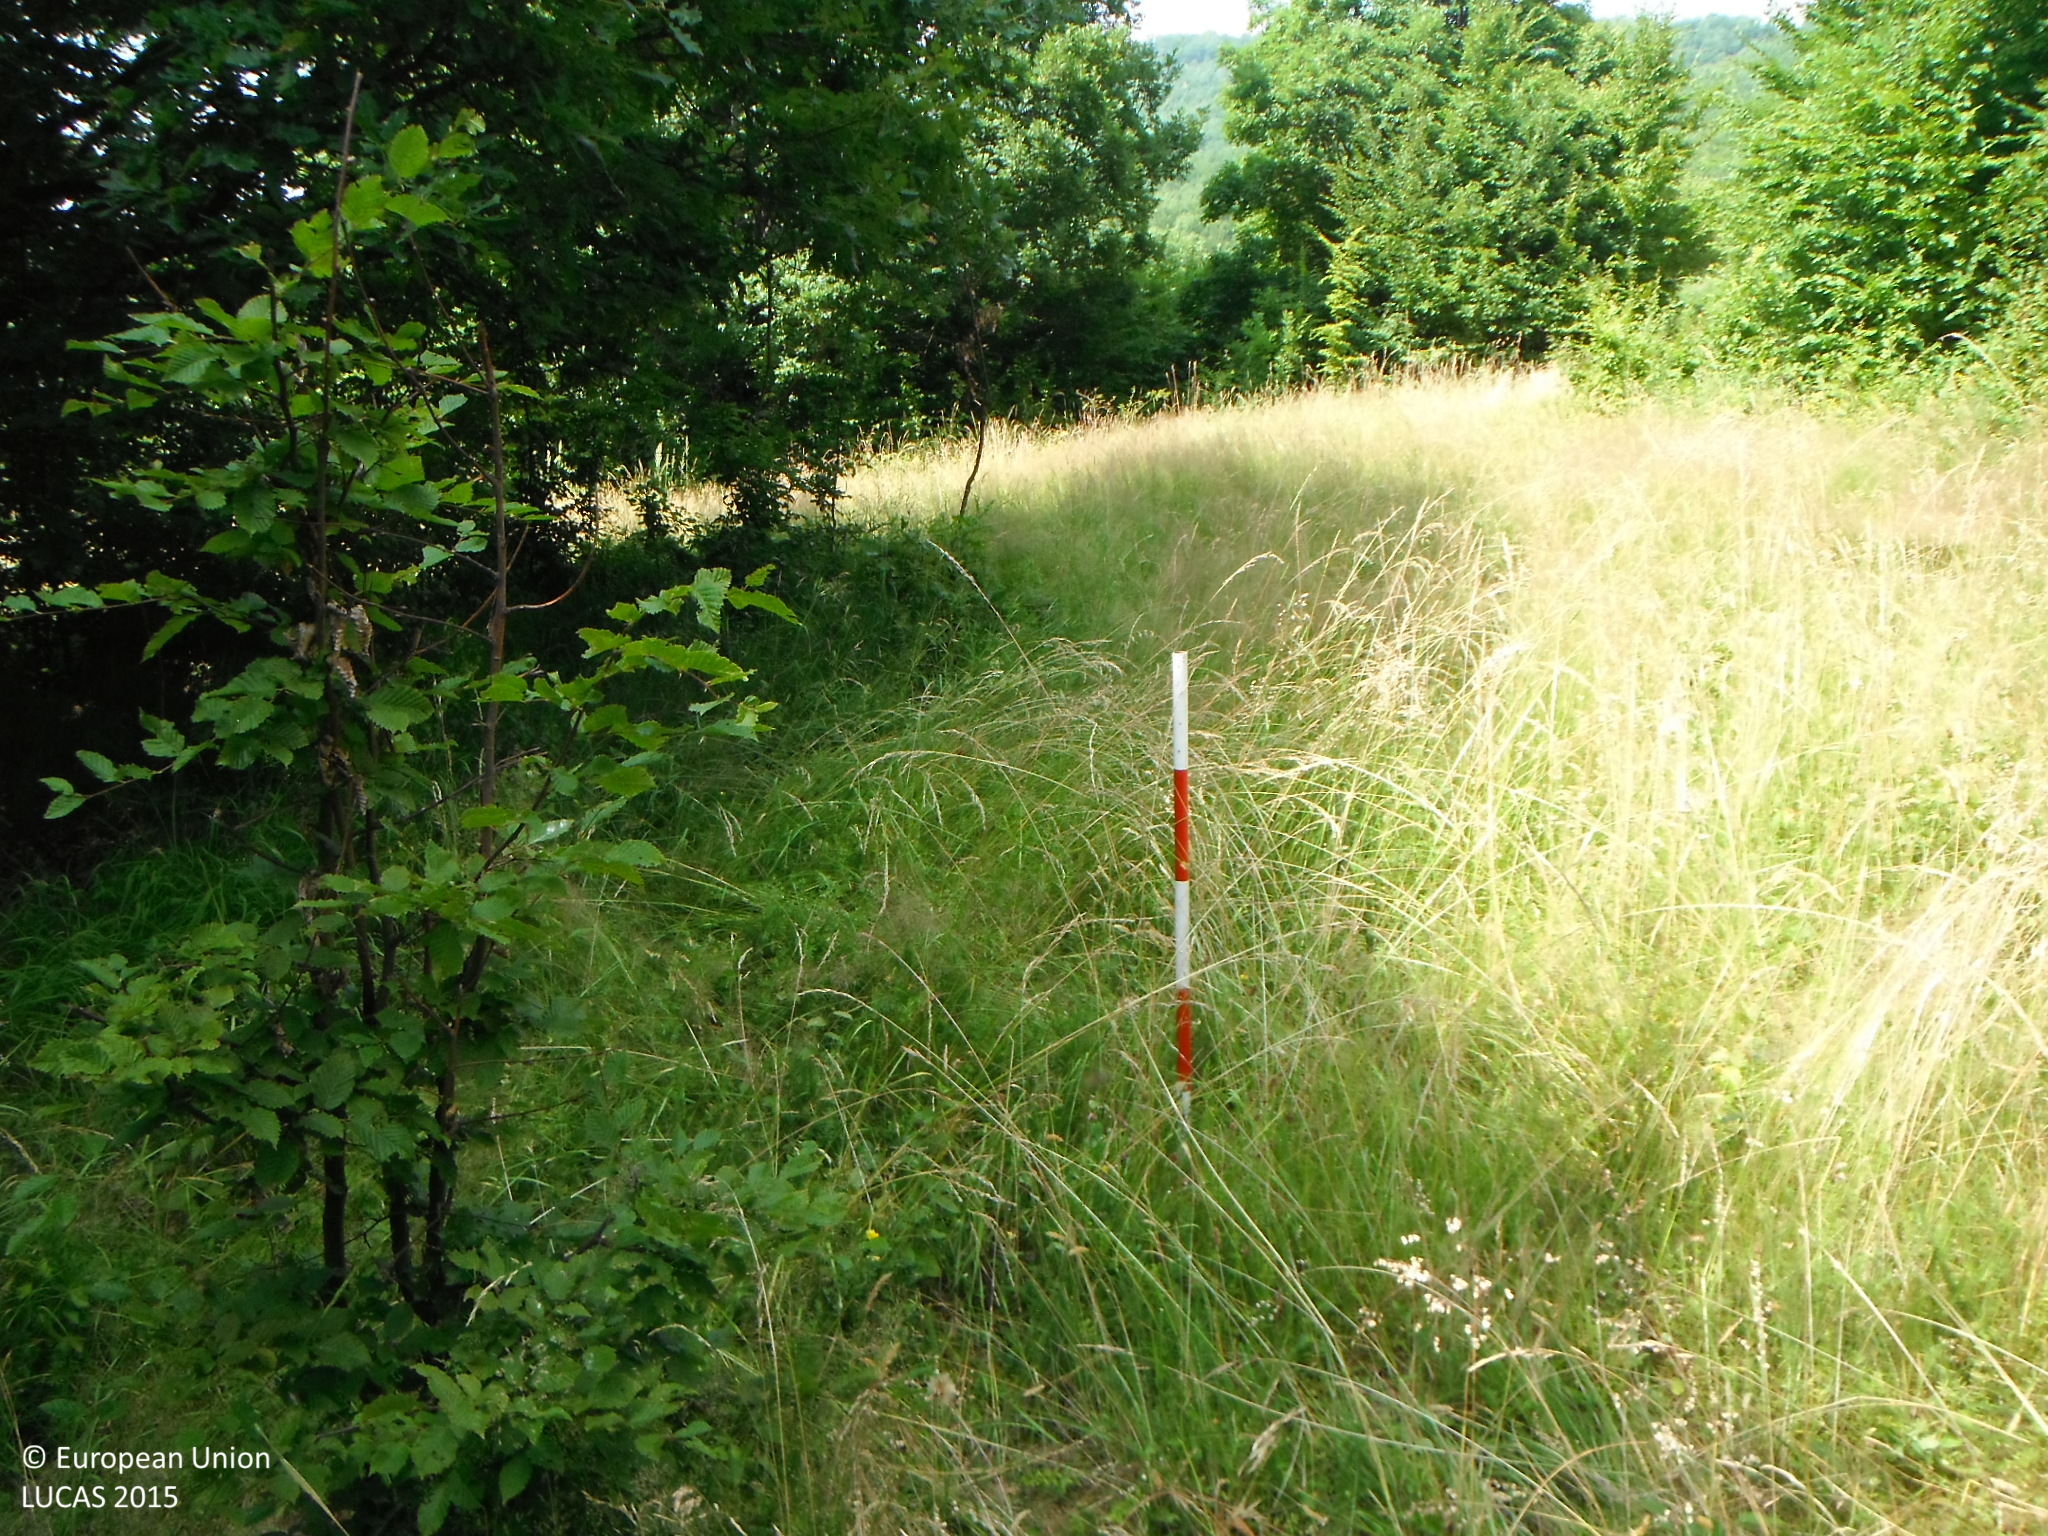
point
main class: Grassland
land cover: Grassland with sparse tree/shrub cover
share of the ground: > 75 %
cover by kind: herbaceous plants 85 %, shrubs 10 %, broadleaved forest trees 5 %
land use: Agriculture (excluding fallow land and kitchen gardens)
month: July
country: SK
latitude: 48.5071
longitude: 19.2130
